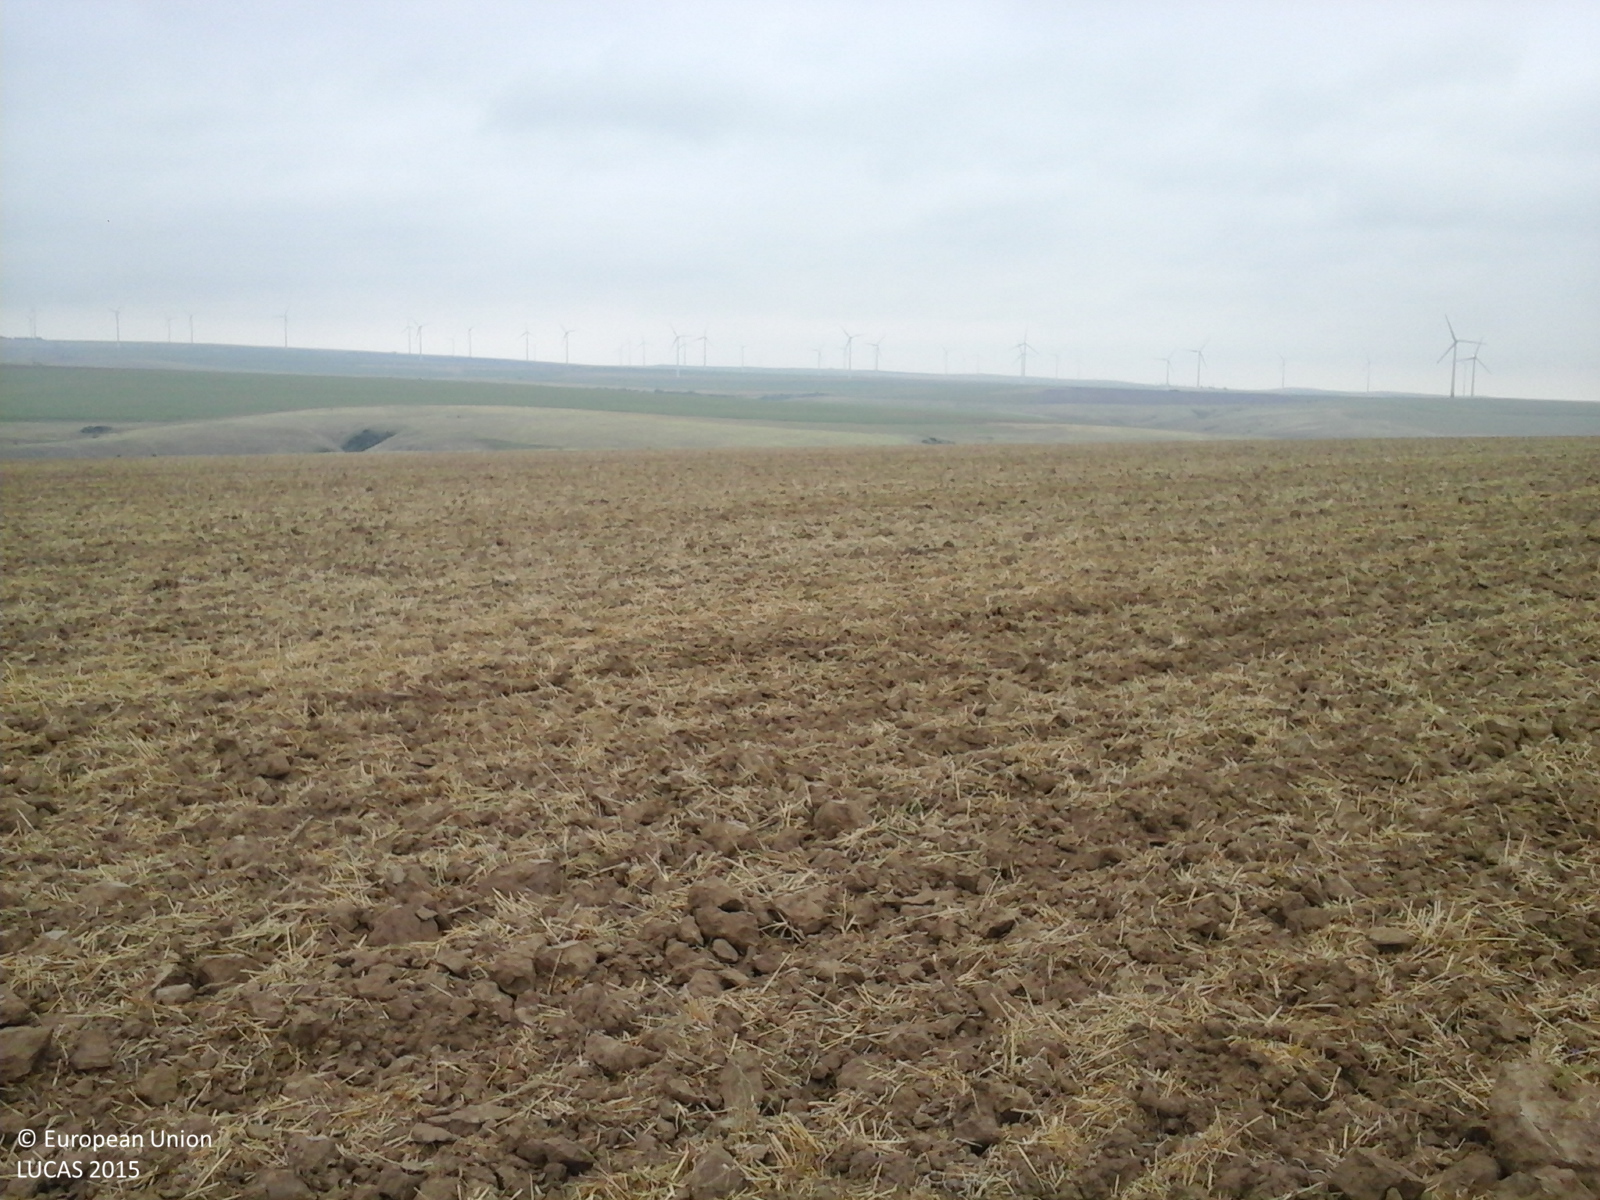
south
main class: Cropland
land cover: Common wheat
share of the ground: < 10 %
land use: Agriculture (excluding fallow land and kitchen gardens)
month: August
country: RO
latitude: 44.8249
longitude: 28.3208
